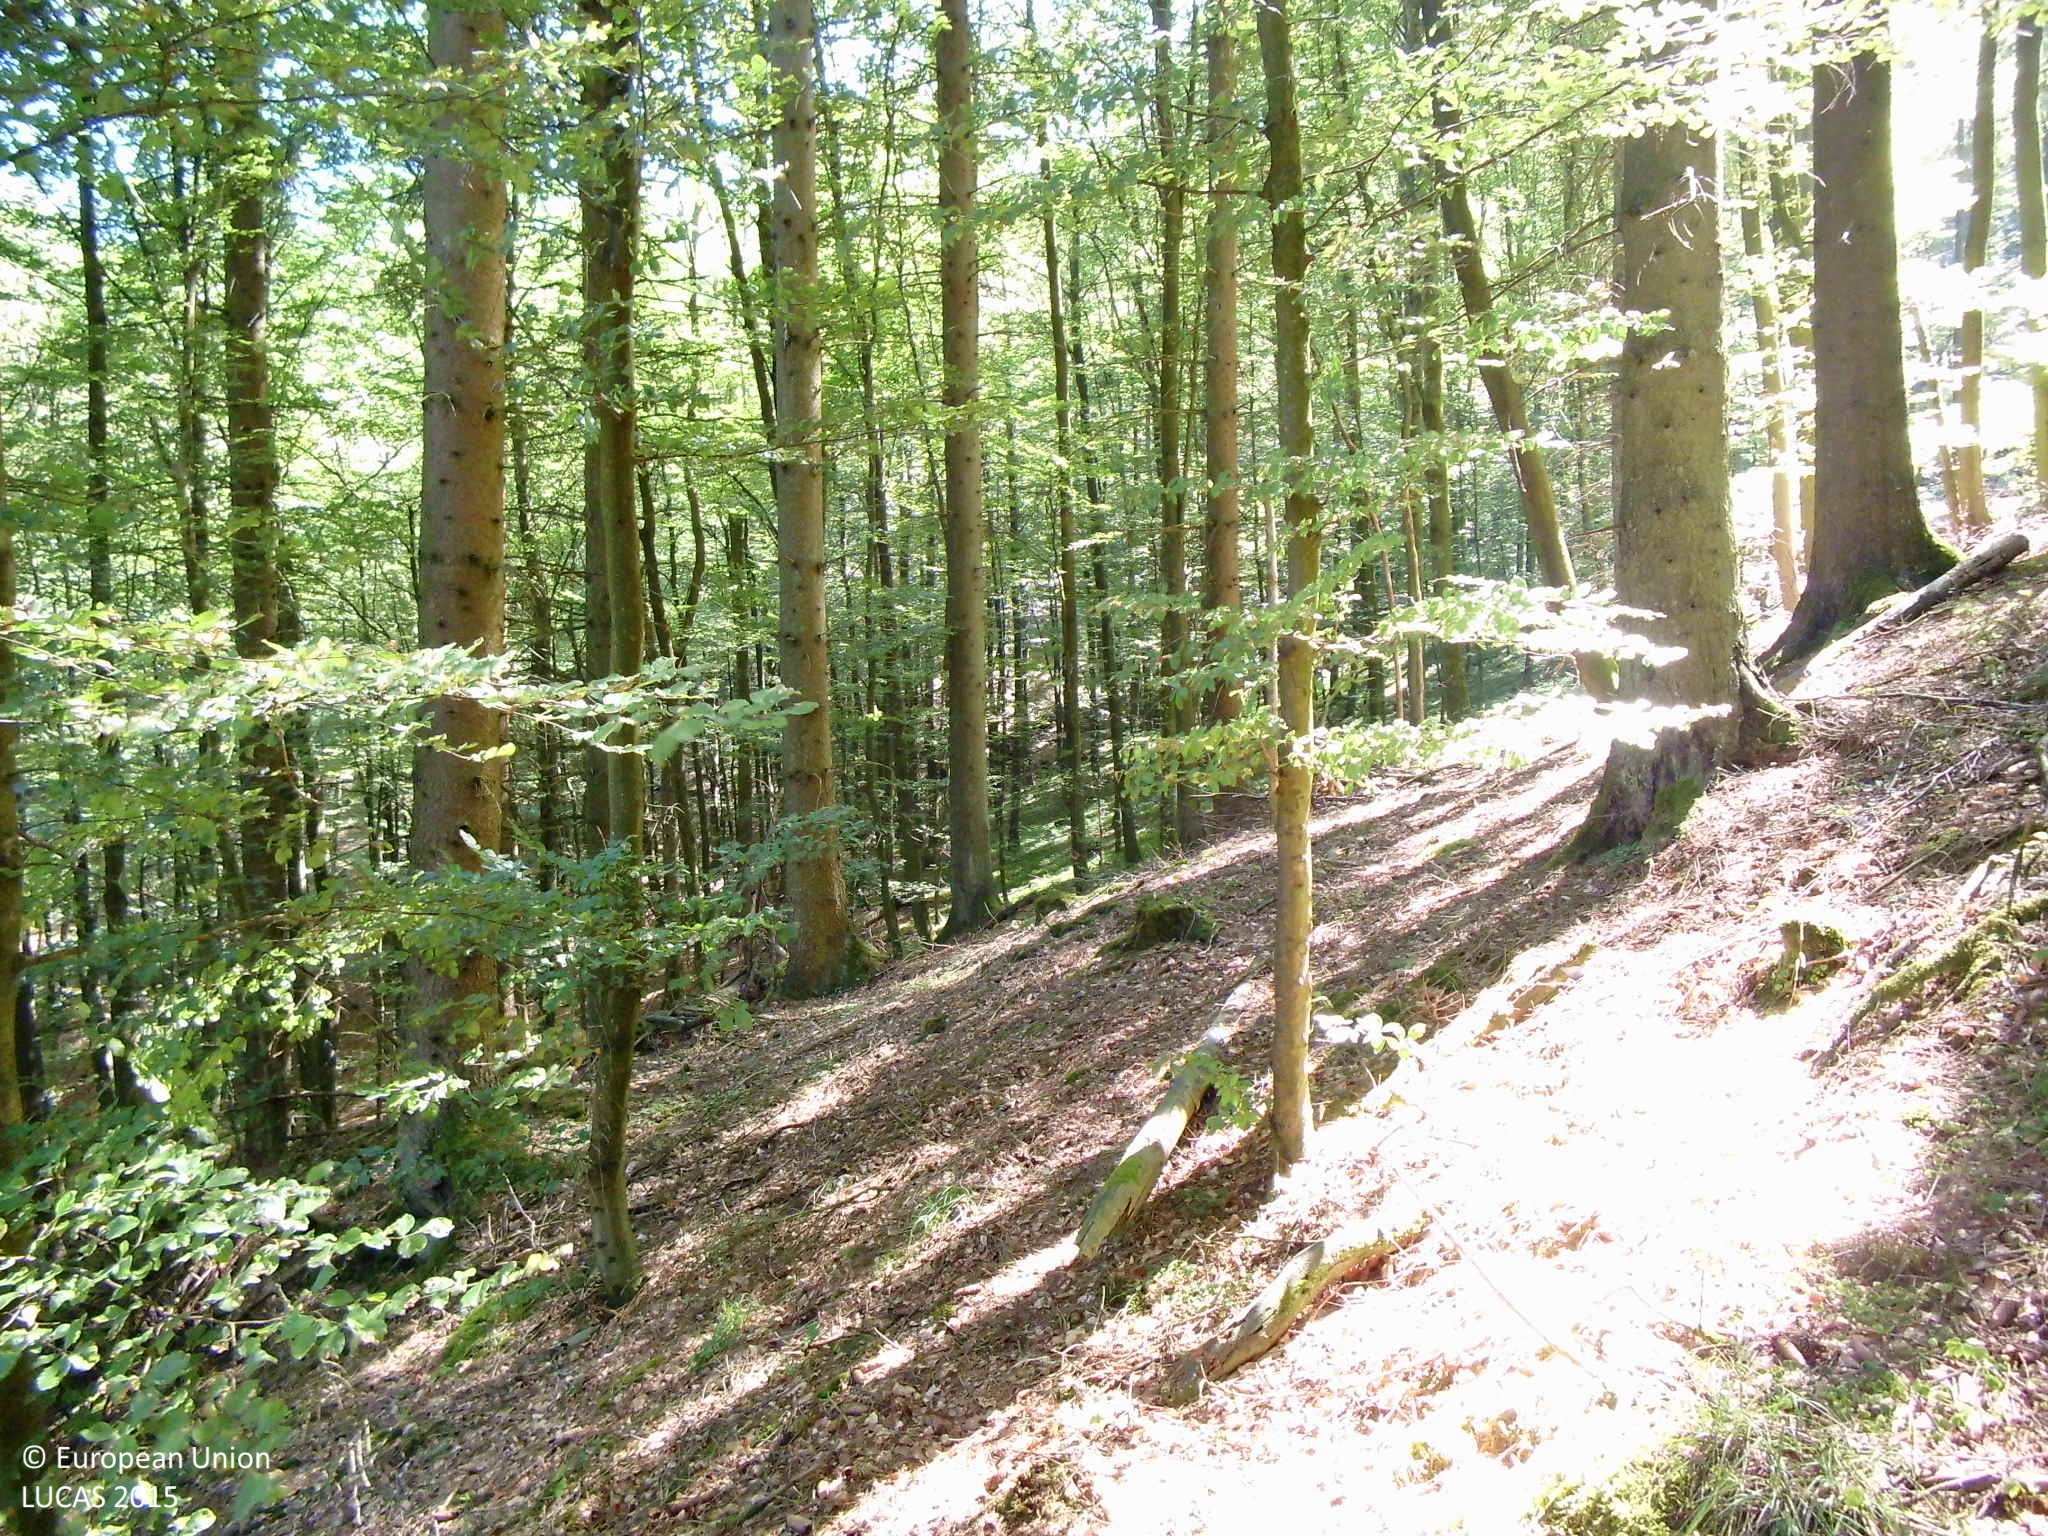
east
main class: Woodland
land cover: Spruce dominated mixed woodland
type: hemiboreal forest and nemoral coniferous forest and mixed broadleaved-coniferous forest
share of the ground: > 75 %
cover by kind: coniferous forest trees 60 %, broadleaved forest trees 25 %, herbaceous plants 5 %, lichens and mosses 5 %, unconsolidated bare surface 5 %
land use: Forestry
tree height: > 5 m
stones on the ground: < 10 %
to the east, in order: Spruce dominated mixed woodland; Broadleaved woodland; Rivers and streams; Broadleaved woodland; Tracks; Other mixed woodland; Broadleaved woodland; Tracks; Spruce dominated mixed woodland
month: August
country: DE
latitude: 51.1022
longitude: 8.0153
